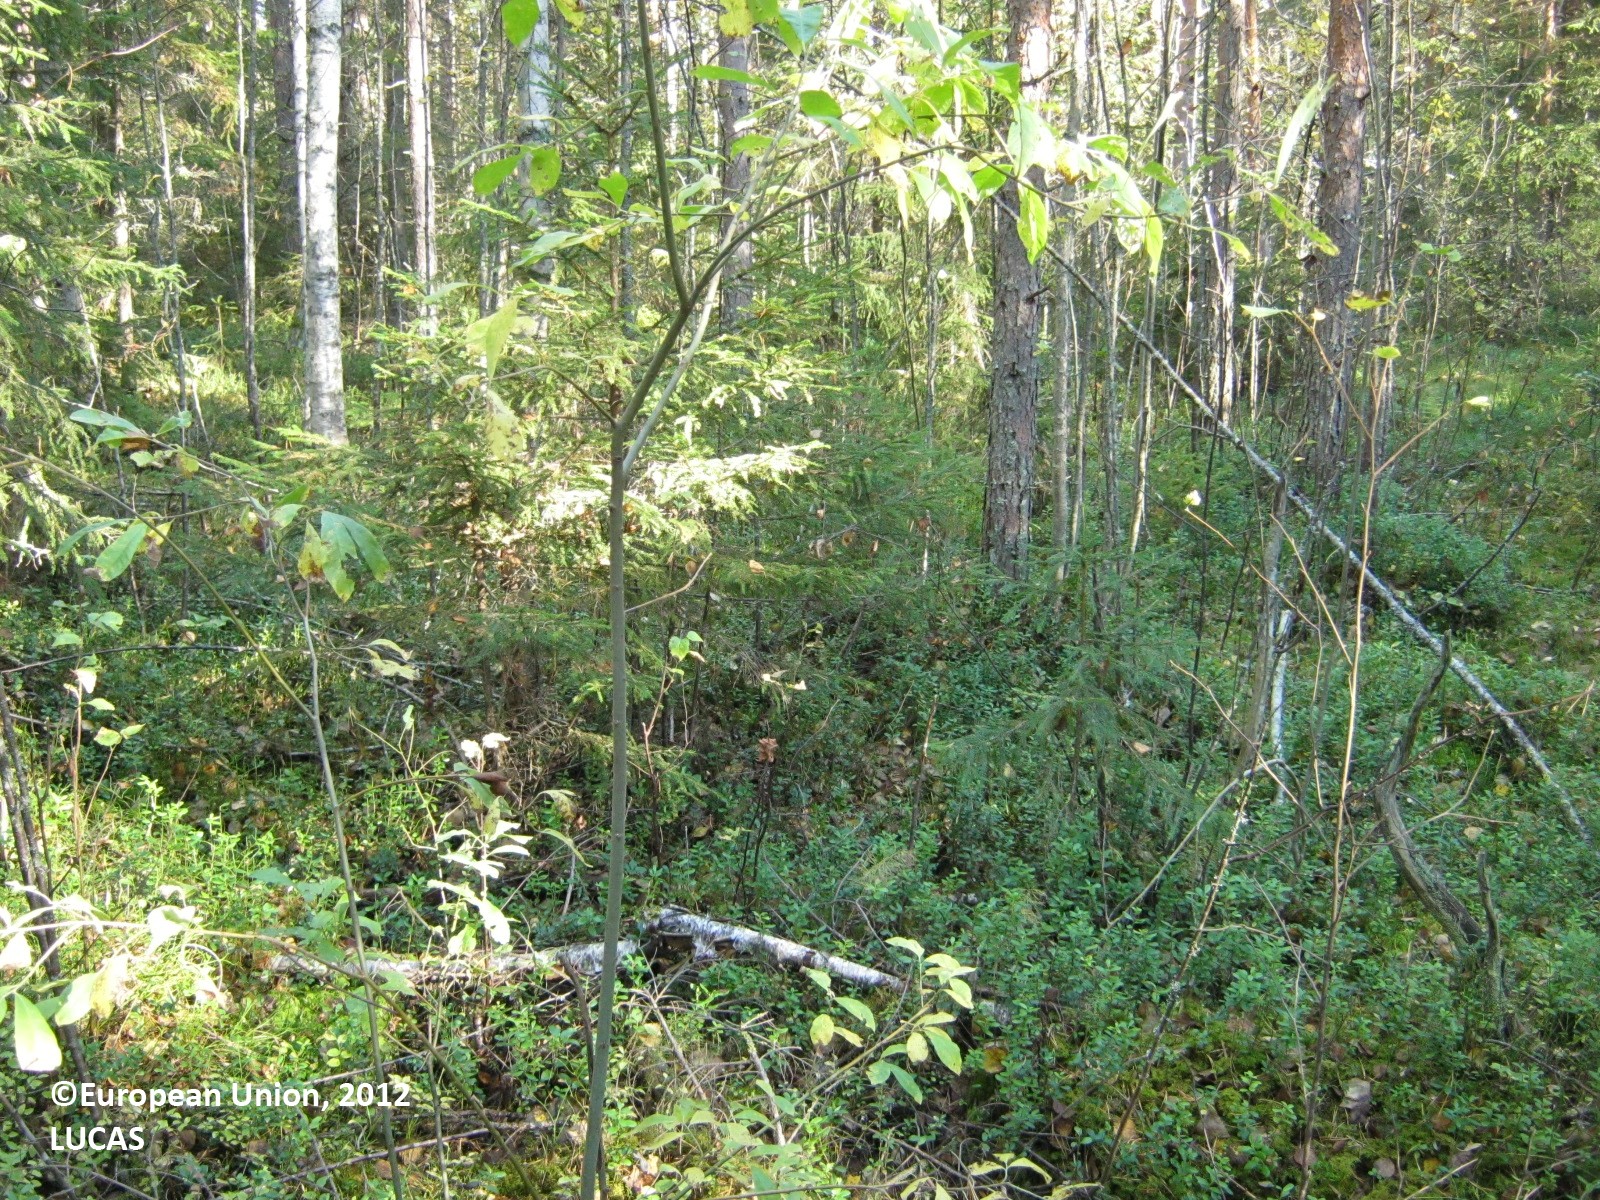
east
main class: Woodland
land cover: Spruce dominated coniferous woodland
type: boreal forest
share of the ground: > 75 %
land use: Forestry
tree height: > 5 m
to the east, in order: Spruce dominated coniferous woodland; Broadleaved woodland; Ditches and canals; Spruce dominated mixed woodland; Spruce dominated coniferous woodland
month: September
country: FI
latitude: 63.2764
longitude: 25.8794
